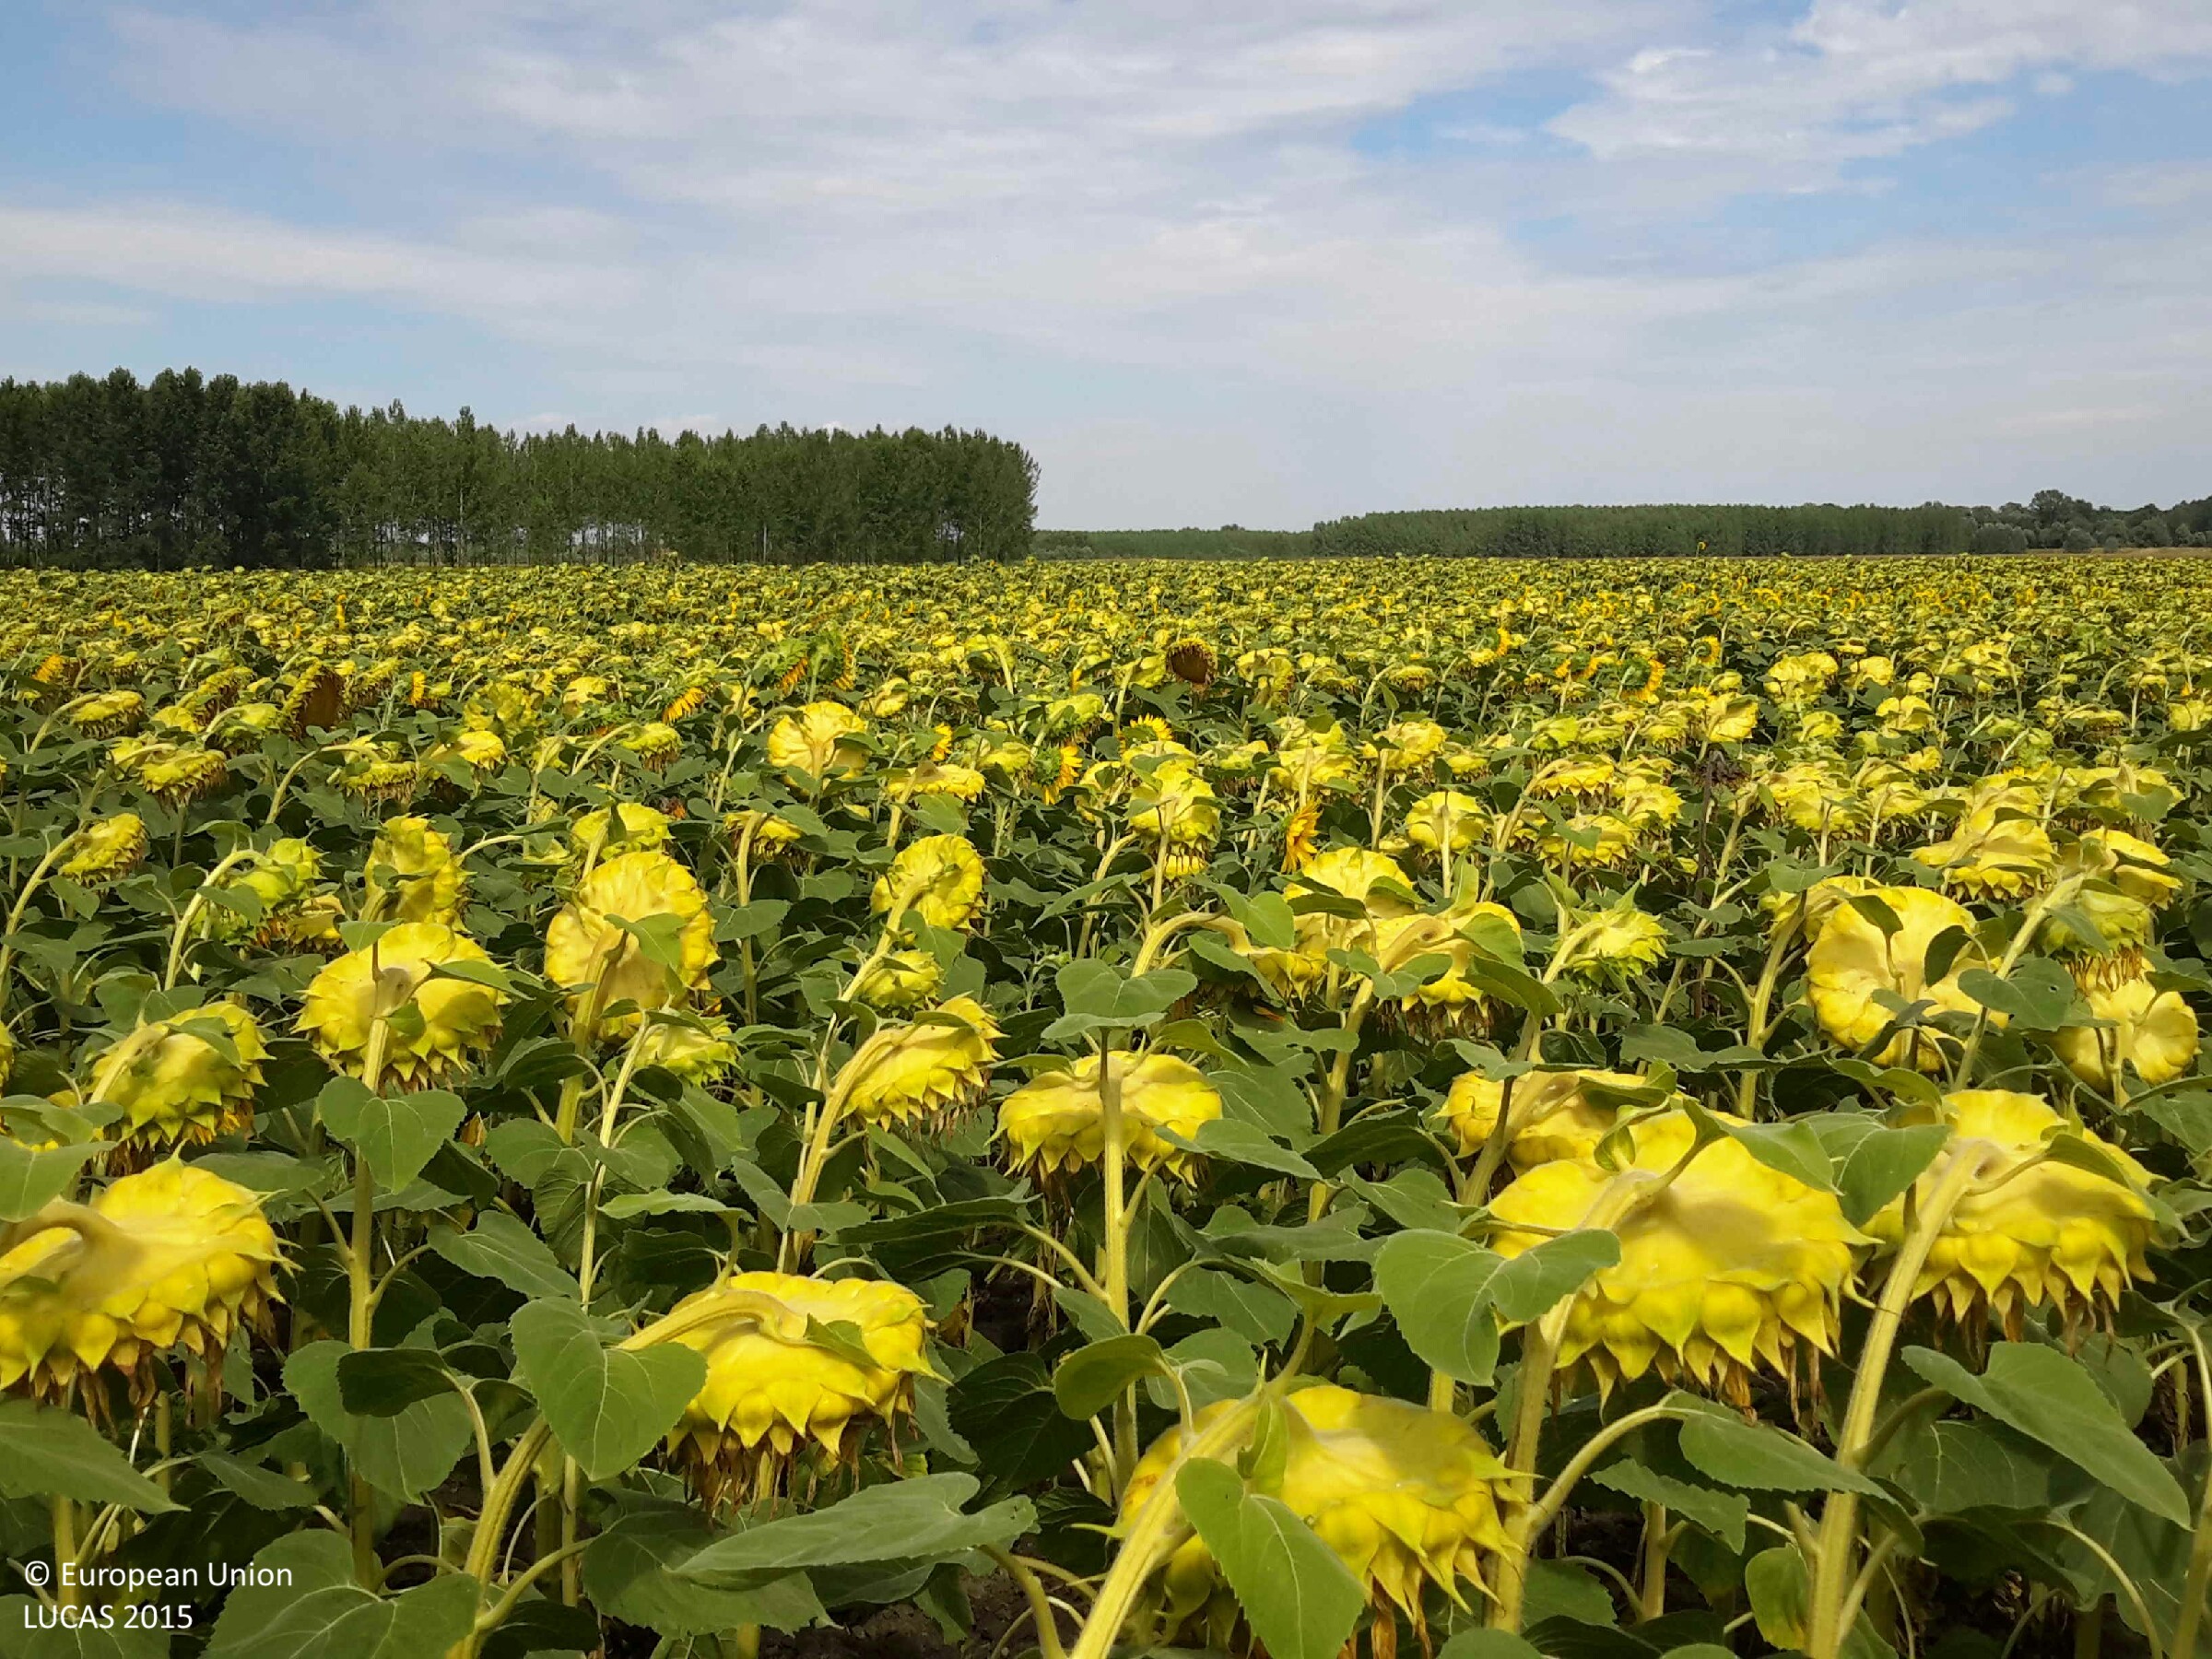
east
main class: Cropland
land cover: Sunflower
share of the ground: > 75 %
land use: Agriculture (excluding fallow land and kitchen gardens)
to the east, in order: Sunflower; Grass margins; Tracks; Grass margins; Ditches and canals; Grass margins; Sunflower
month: July
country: HU
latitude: 47.5887
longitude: 17.4948
